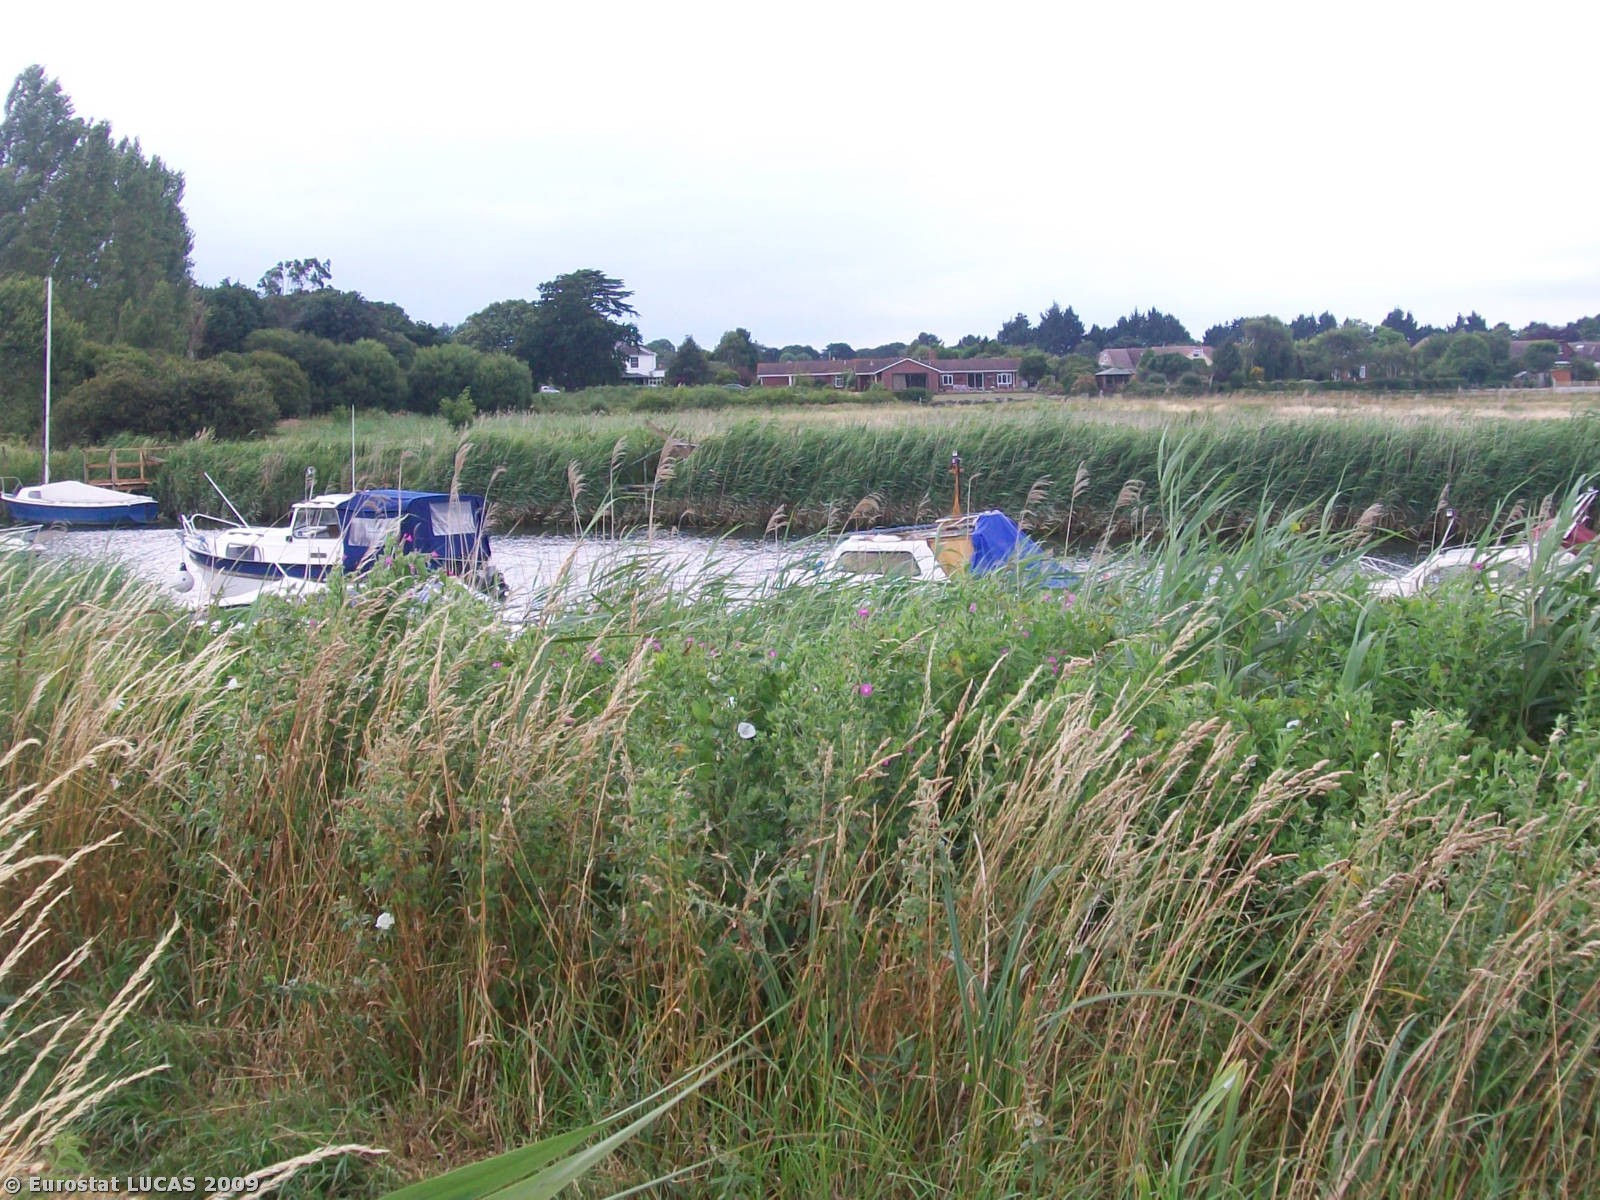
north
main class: Grassland
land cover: Grassland without tree/shrub cover
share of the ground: > 75 %
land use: Agriculture (excluding fallow land and kitchen gardens)
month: July
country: GB
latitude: 50.6823
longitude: -2.1039
